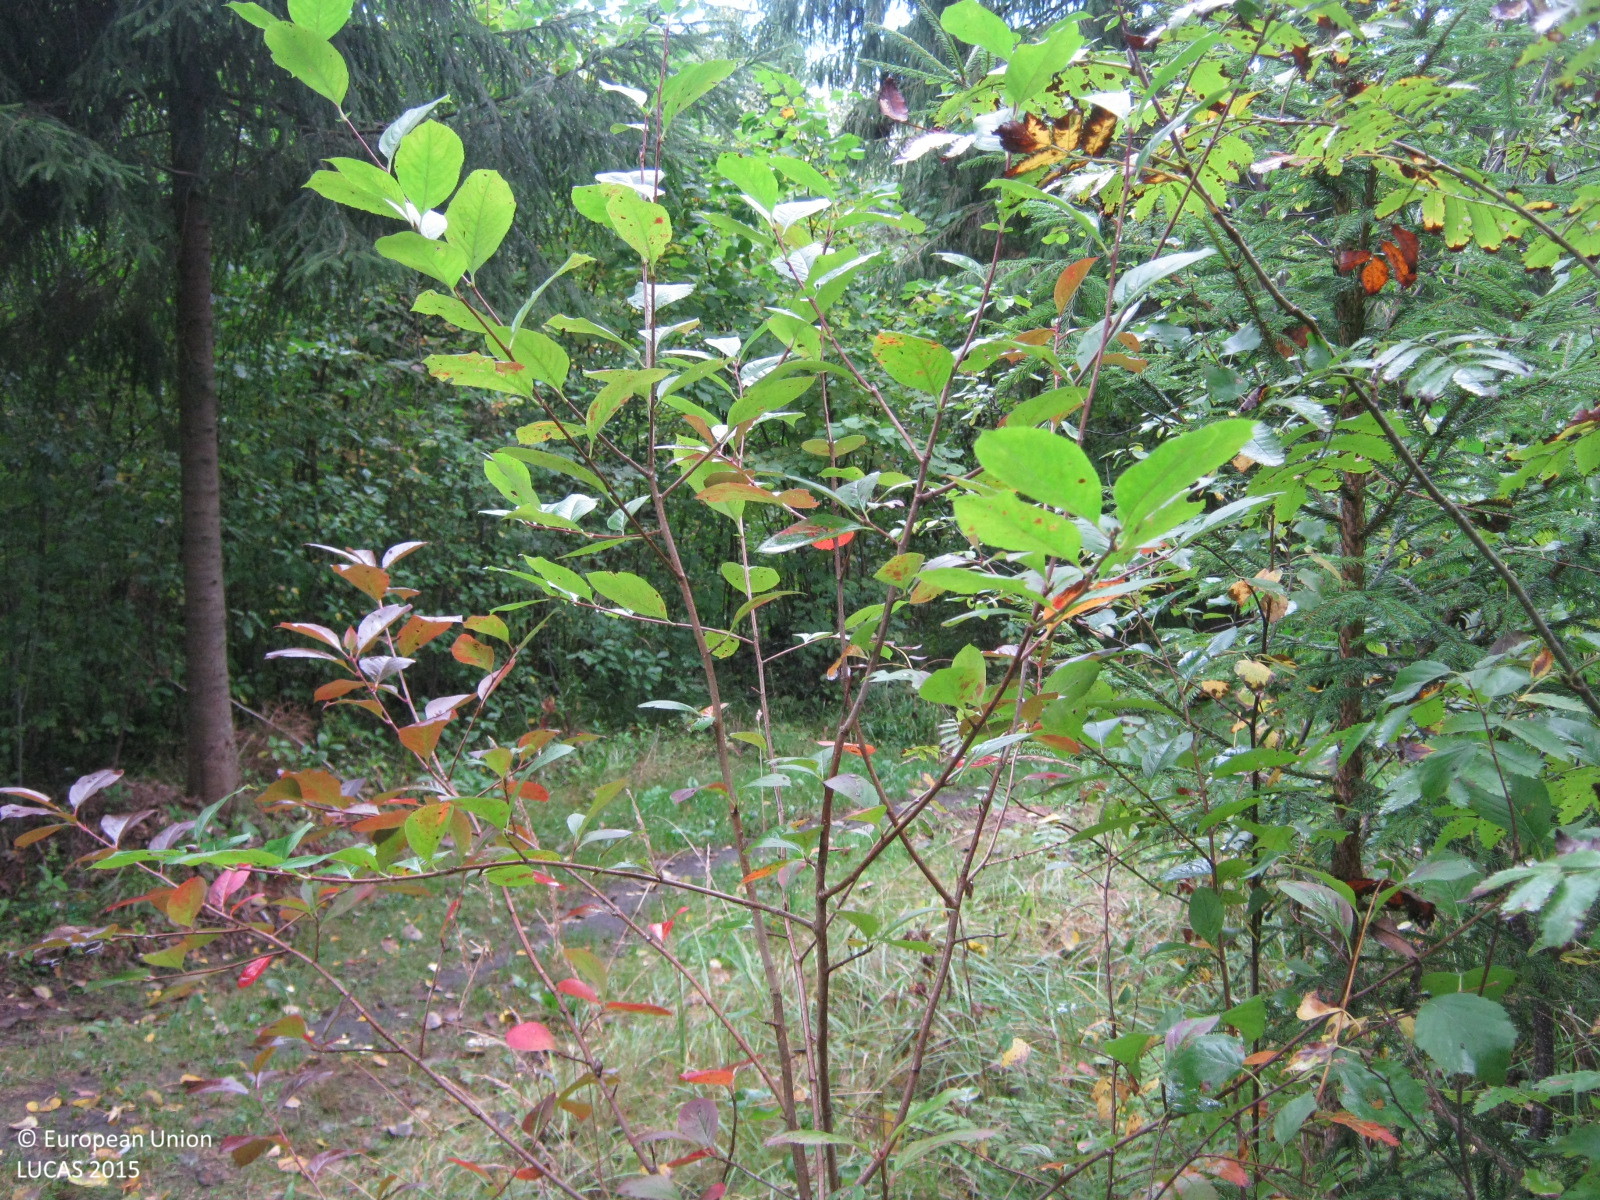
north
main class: Woodland
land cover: Broadleaved woodland
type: non-riverine alder, birch or aspen forest
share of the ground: 50 - 75 %
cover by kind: broadleaved forest trees 60 %, herbaceous plants 15 %, coniferous forest trees 10 %, shrubs 10 %, unconsolidated bare surface 5 %
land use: Forestry
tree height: > 5 m
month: September
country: LV
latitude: 57.2483
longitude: 24.4605
